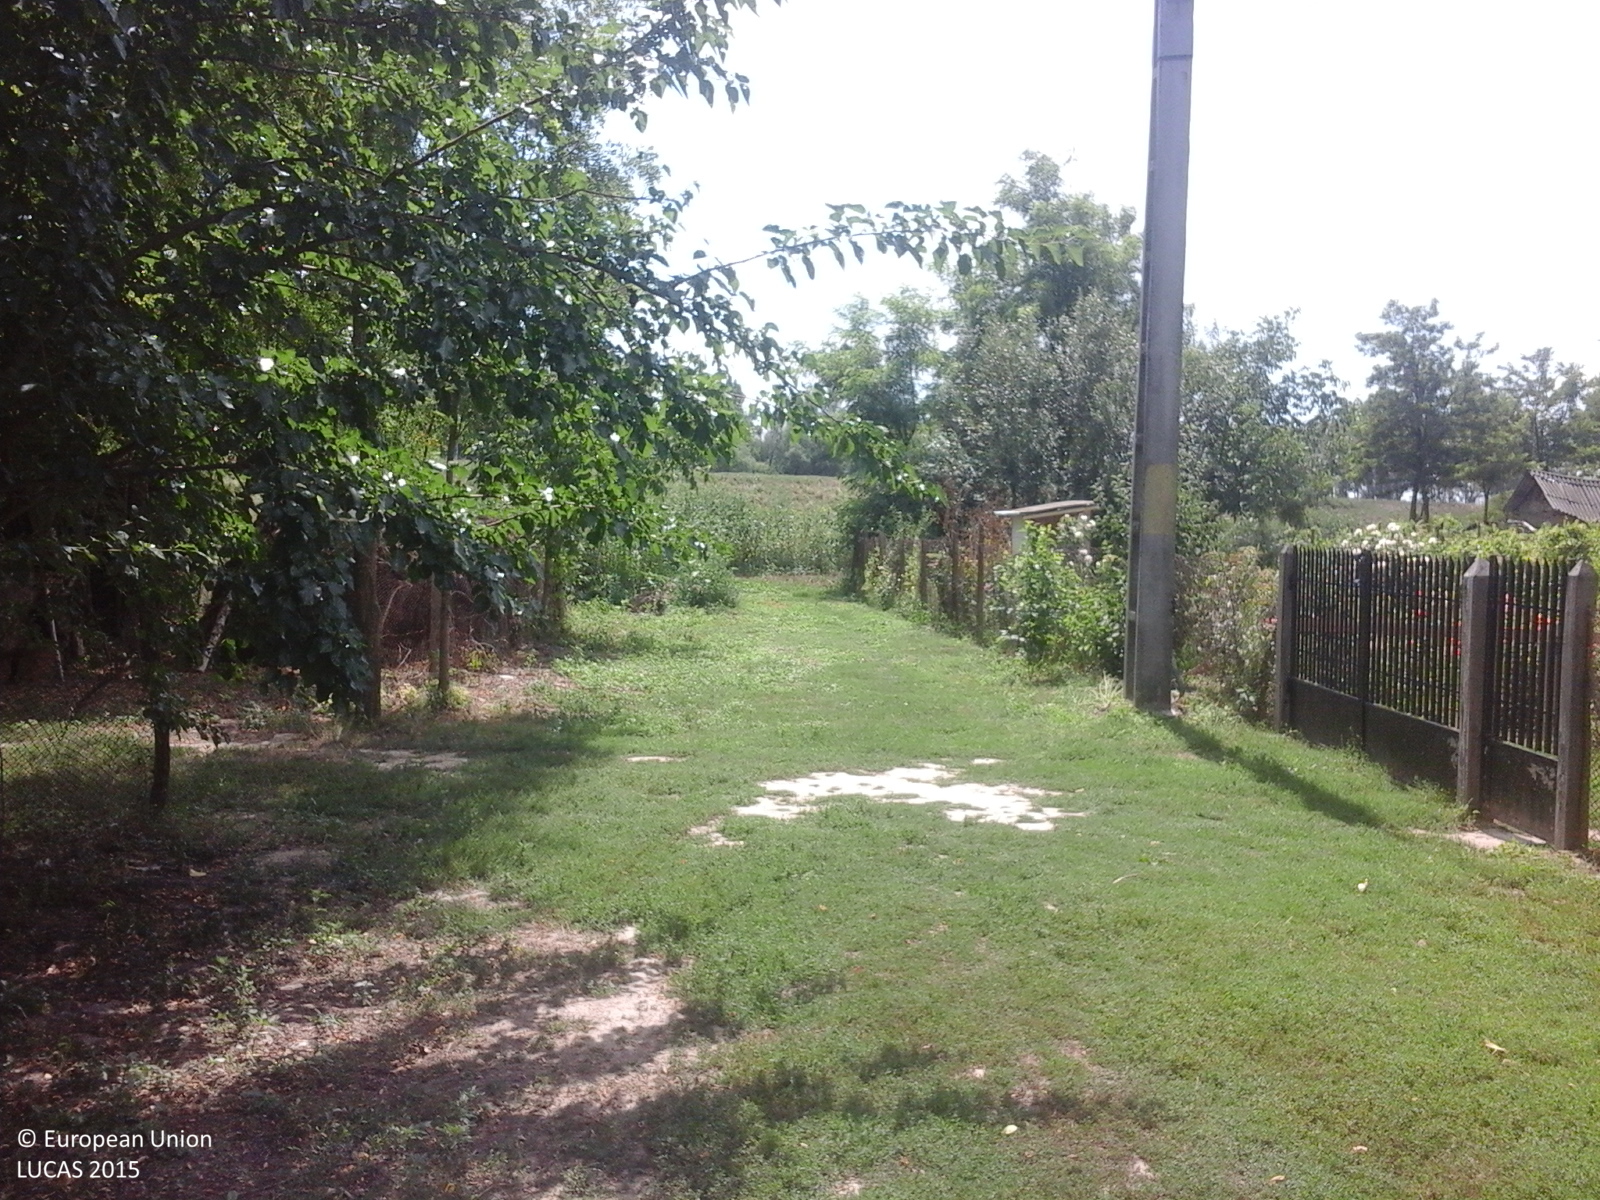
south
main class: Woodland
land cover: Broadleaved woodland
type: exotic forest
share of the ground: > 75 %
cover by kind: broadleaved forest trees 100 %
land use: Agriculture (excluding fallow land and kitchen gardens)
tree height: > 5 m
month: July
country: RO
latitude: 46.4834
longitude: 28.2273
